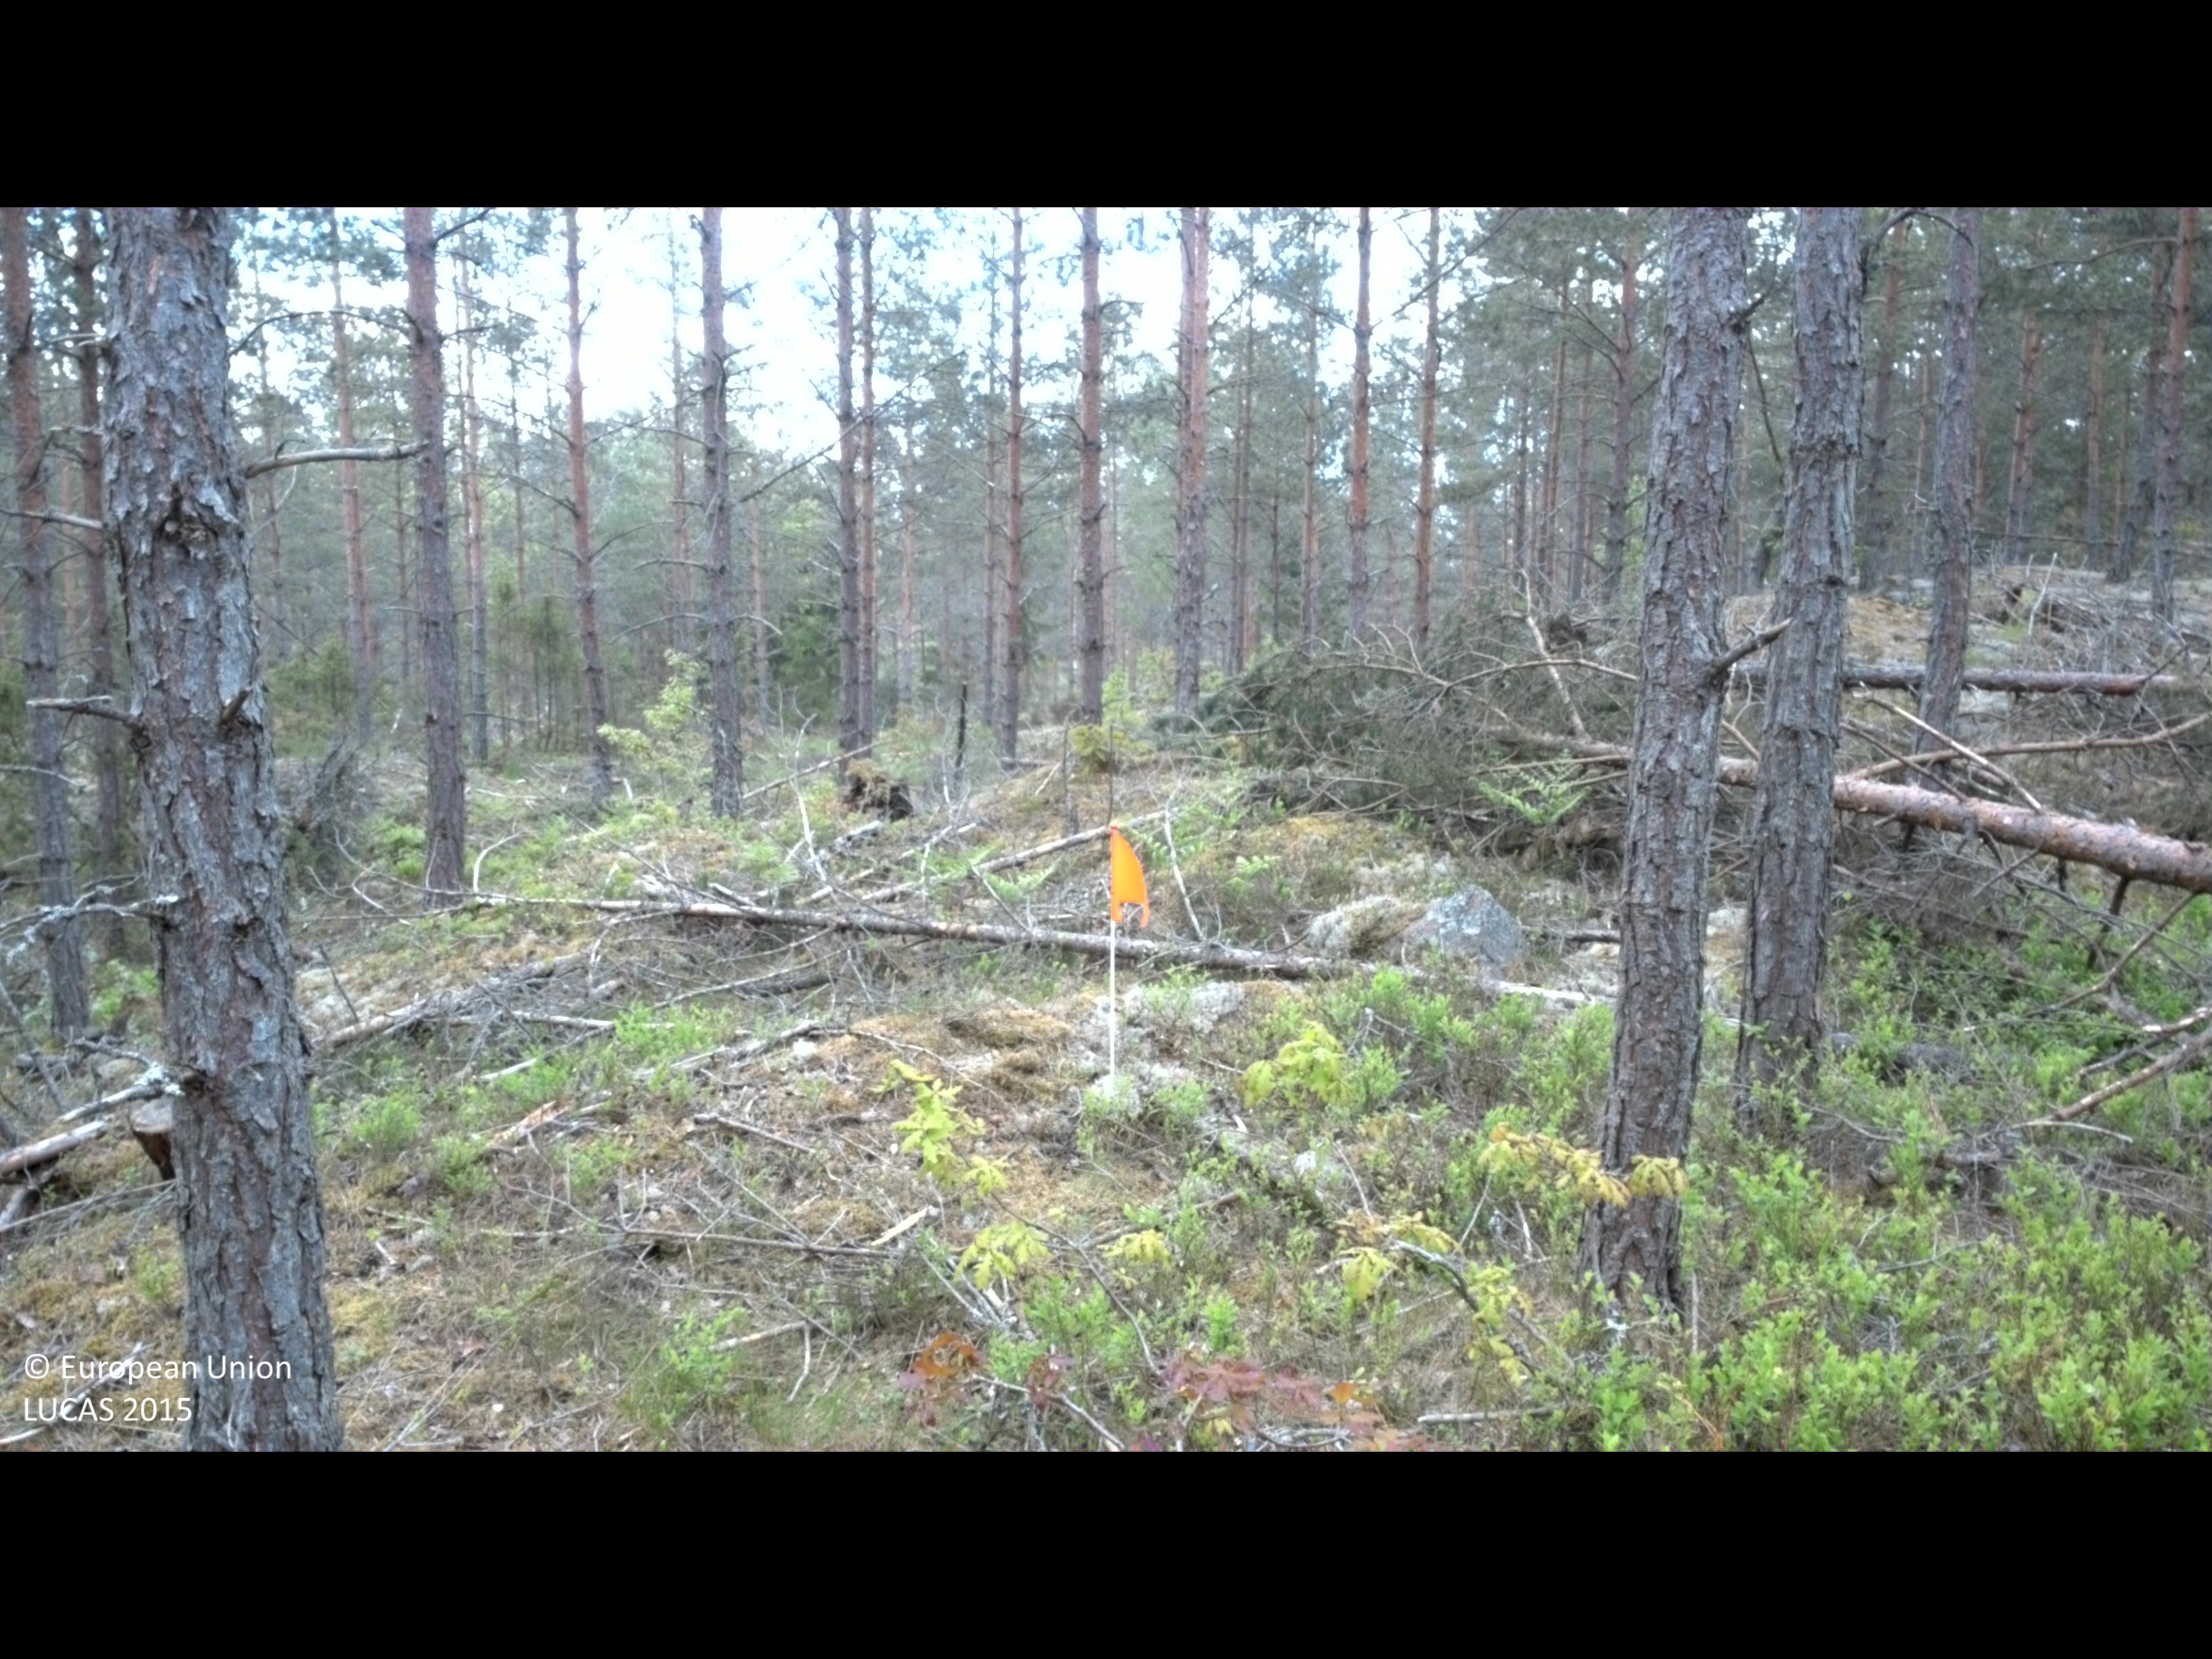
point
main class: Woodland
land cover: Pine dominated coniferous woodland
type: boreal forest
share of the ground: 50 - 75 %
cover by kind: coniferous forest trees 65 %, shrubs 15 %, lichens and mosses 15 %, herbaceous plants 5 %
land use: Forestry
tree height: > 5 m
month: May
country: SE
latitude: 57.5015
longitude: 16.5242
